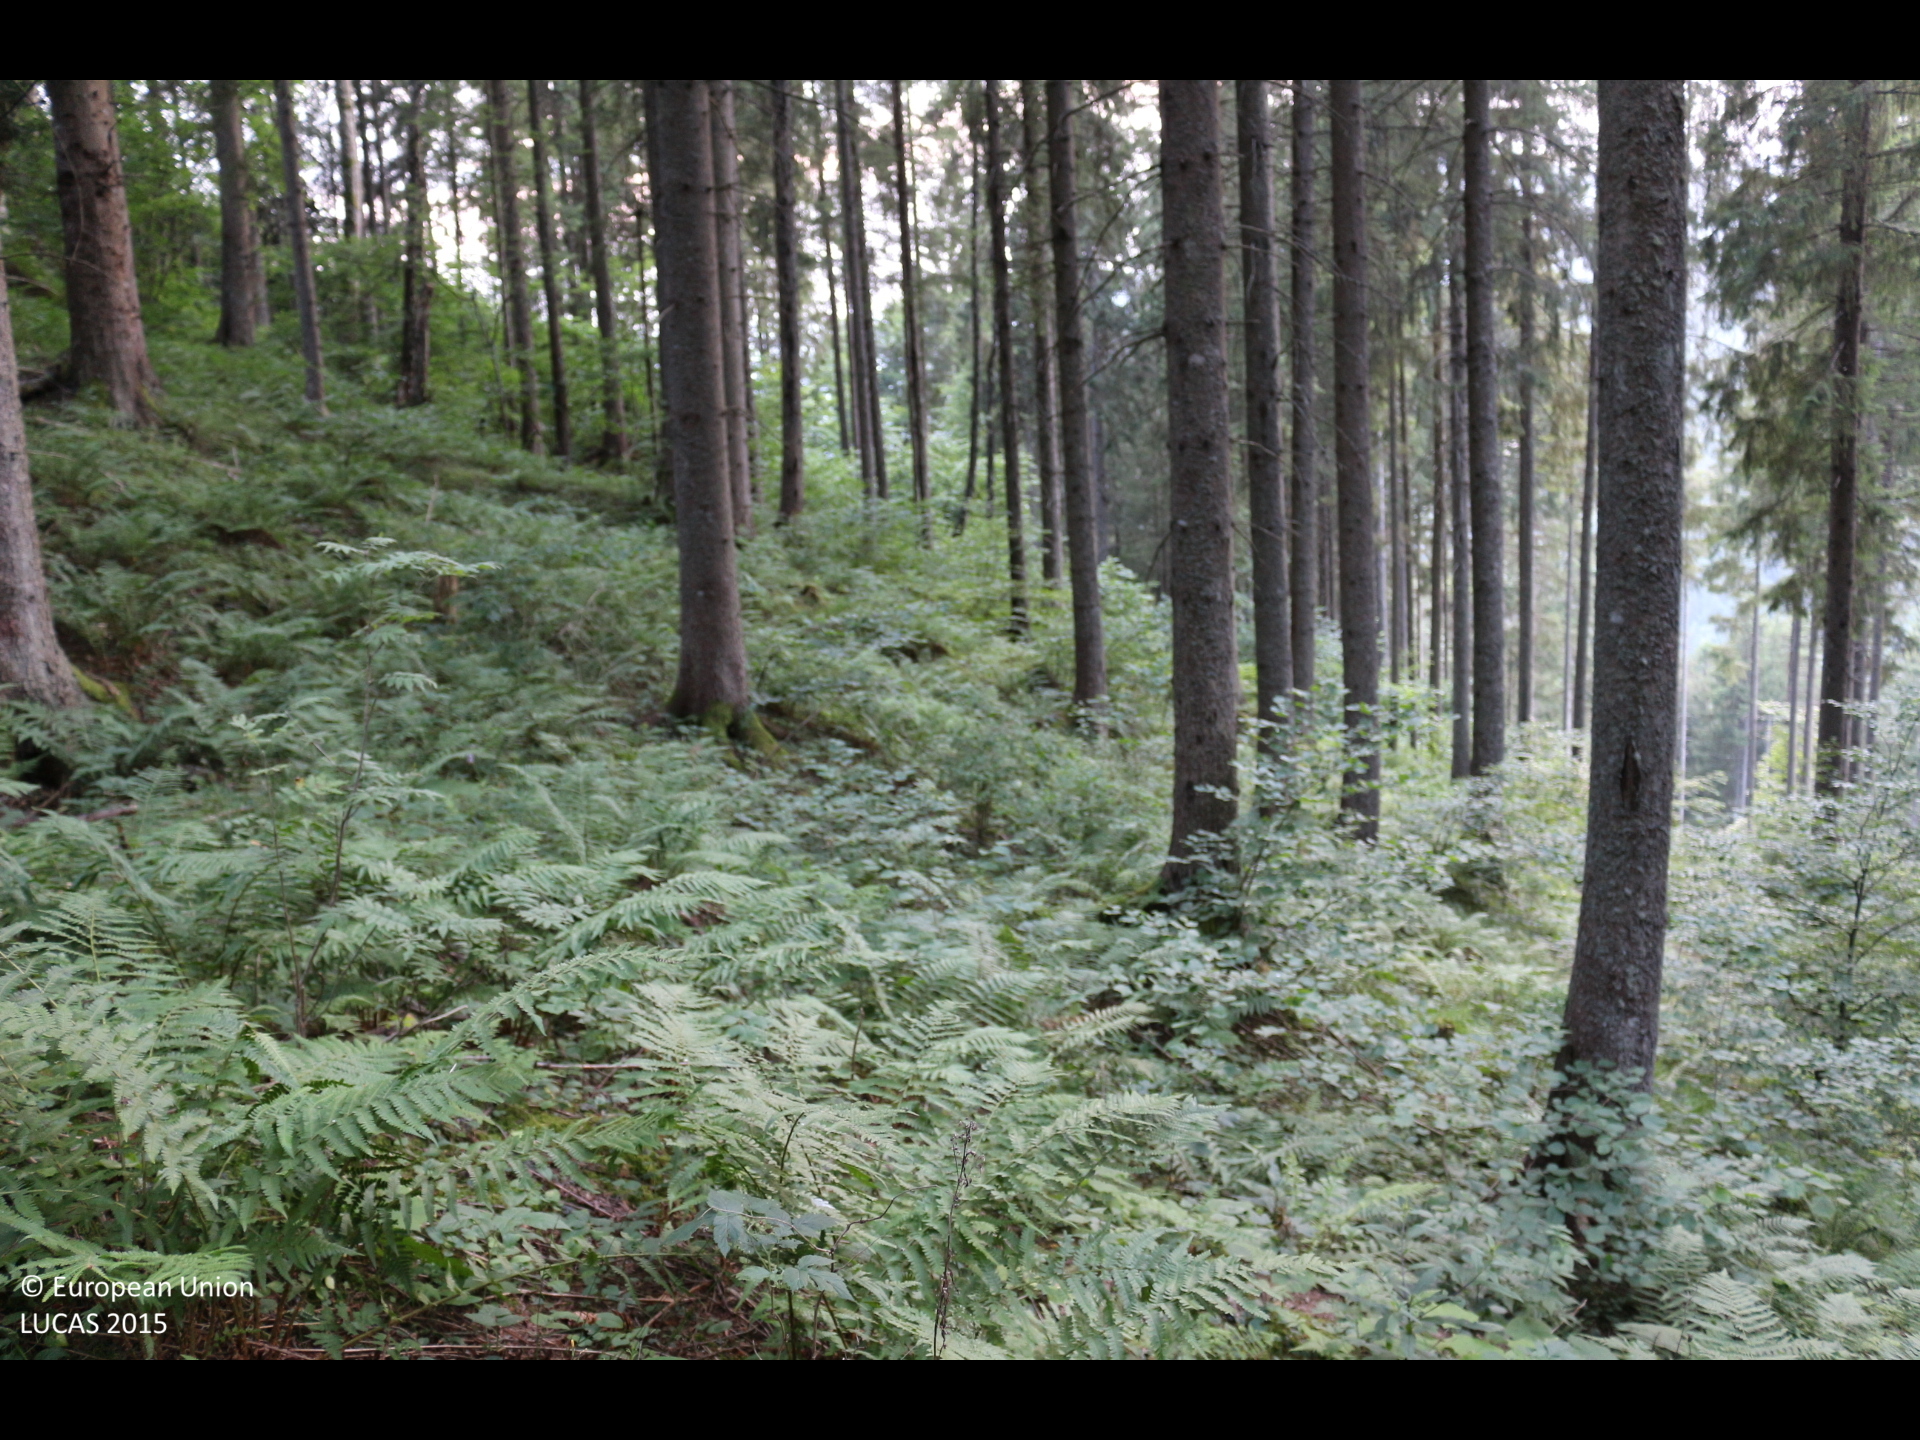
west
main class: Woodland
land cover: Spruce dominated coniferous woodland
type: alpine coniferous forest
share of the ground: > 75 %
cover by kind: coniferous forest trees 100 %
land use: Forestry
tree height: > 5 m
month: July
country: AT
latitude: 46.7936
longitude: 14.1506
